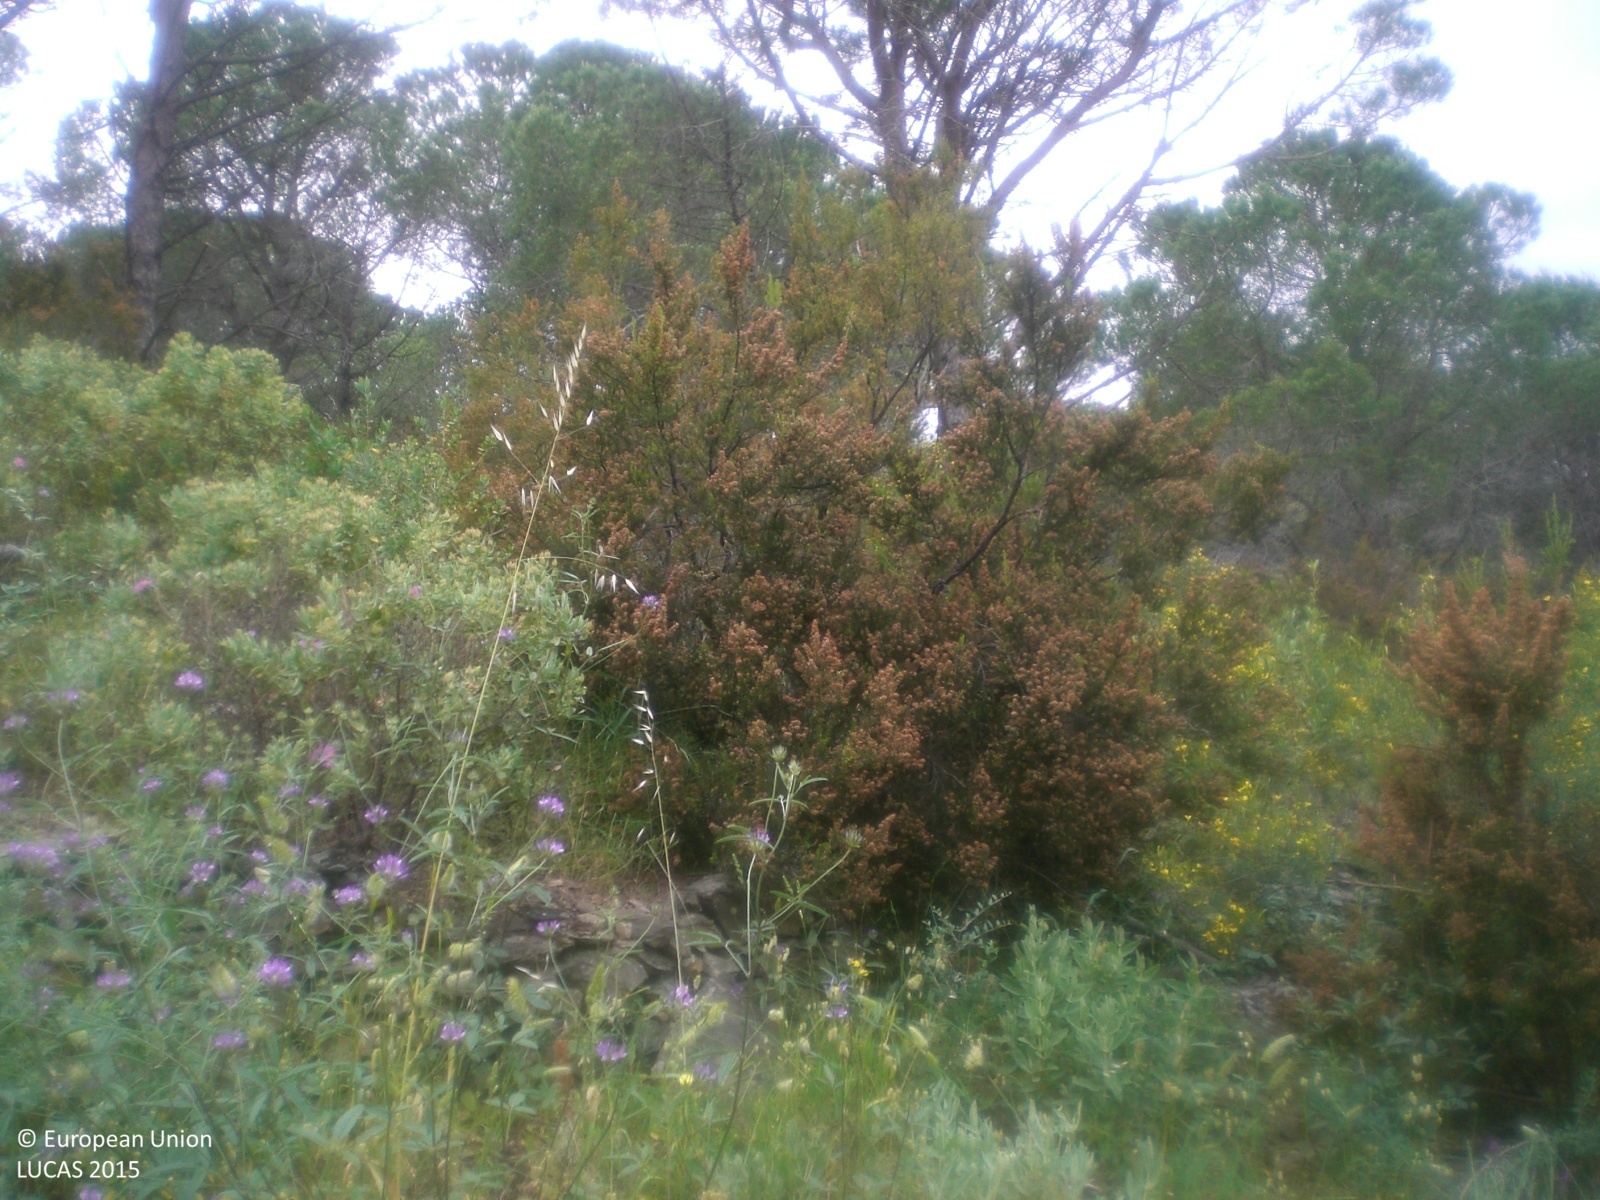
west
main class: Woodland
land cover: Pine dominated mixed woodland
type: coniferous forest of the mediterranean region
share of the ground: 10 - 25 %
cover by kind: herbaceous plants 30 %, coniferous forest trees 25 %, shrubs 25 %, broadleaved forest trees 10 %, consolidated bare surface 10 %
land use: Forestry
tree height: > 5 m
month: May
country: ES
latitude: 42.3171
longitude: 3.2075
